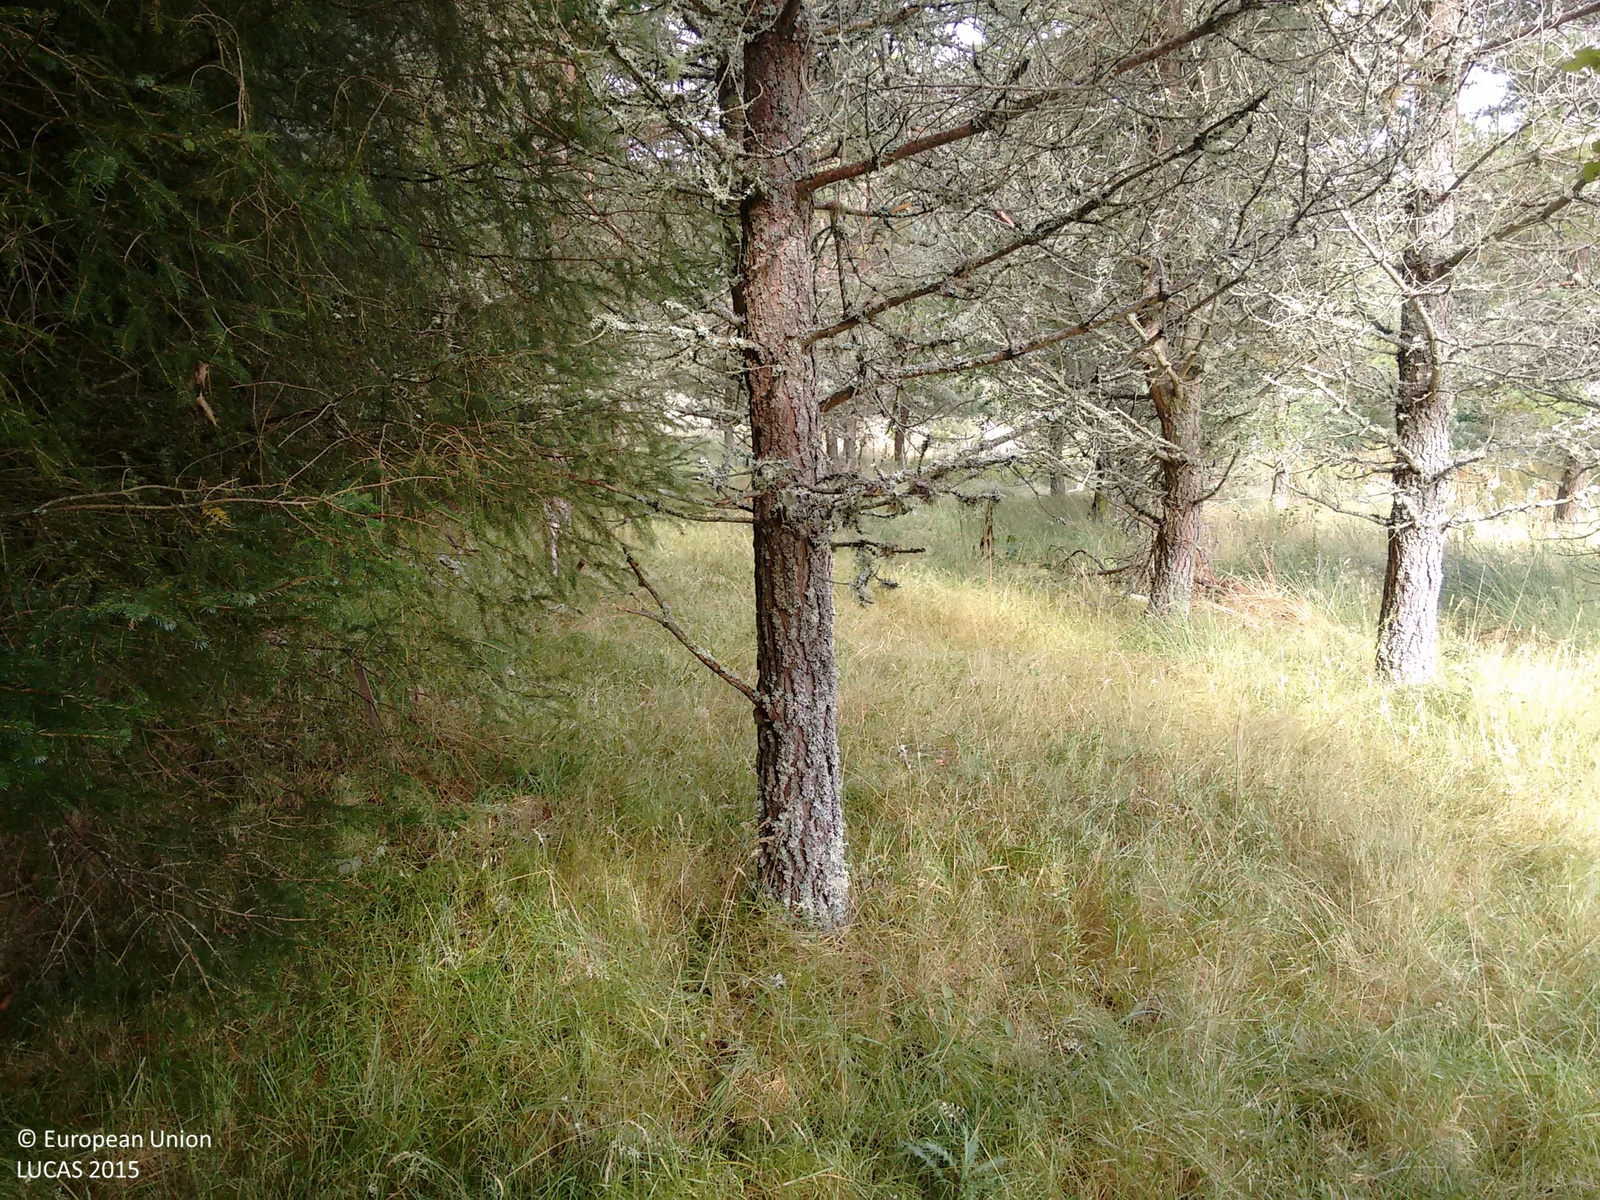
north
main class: Woodland
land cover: Spruce dominated coniferous woodland
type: exotic forest
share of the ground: > 75 %
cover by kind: coniferous forest trees 70 %, herbaceous plants 25 %, broadleaved forest trees 5 %
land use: Forestry
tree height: > 5 m
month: September
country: GB
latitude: 57.3588
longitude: -3.2485
